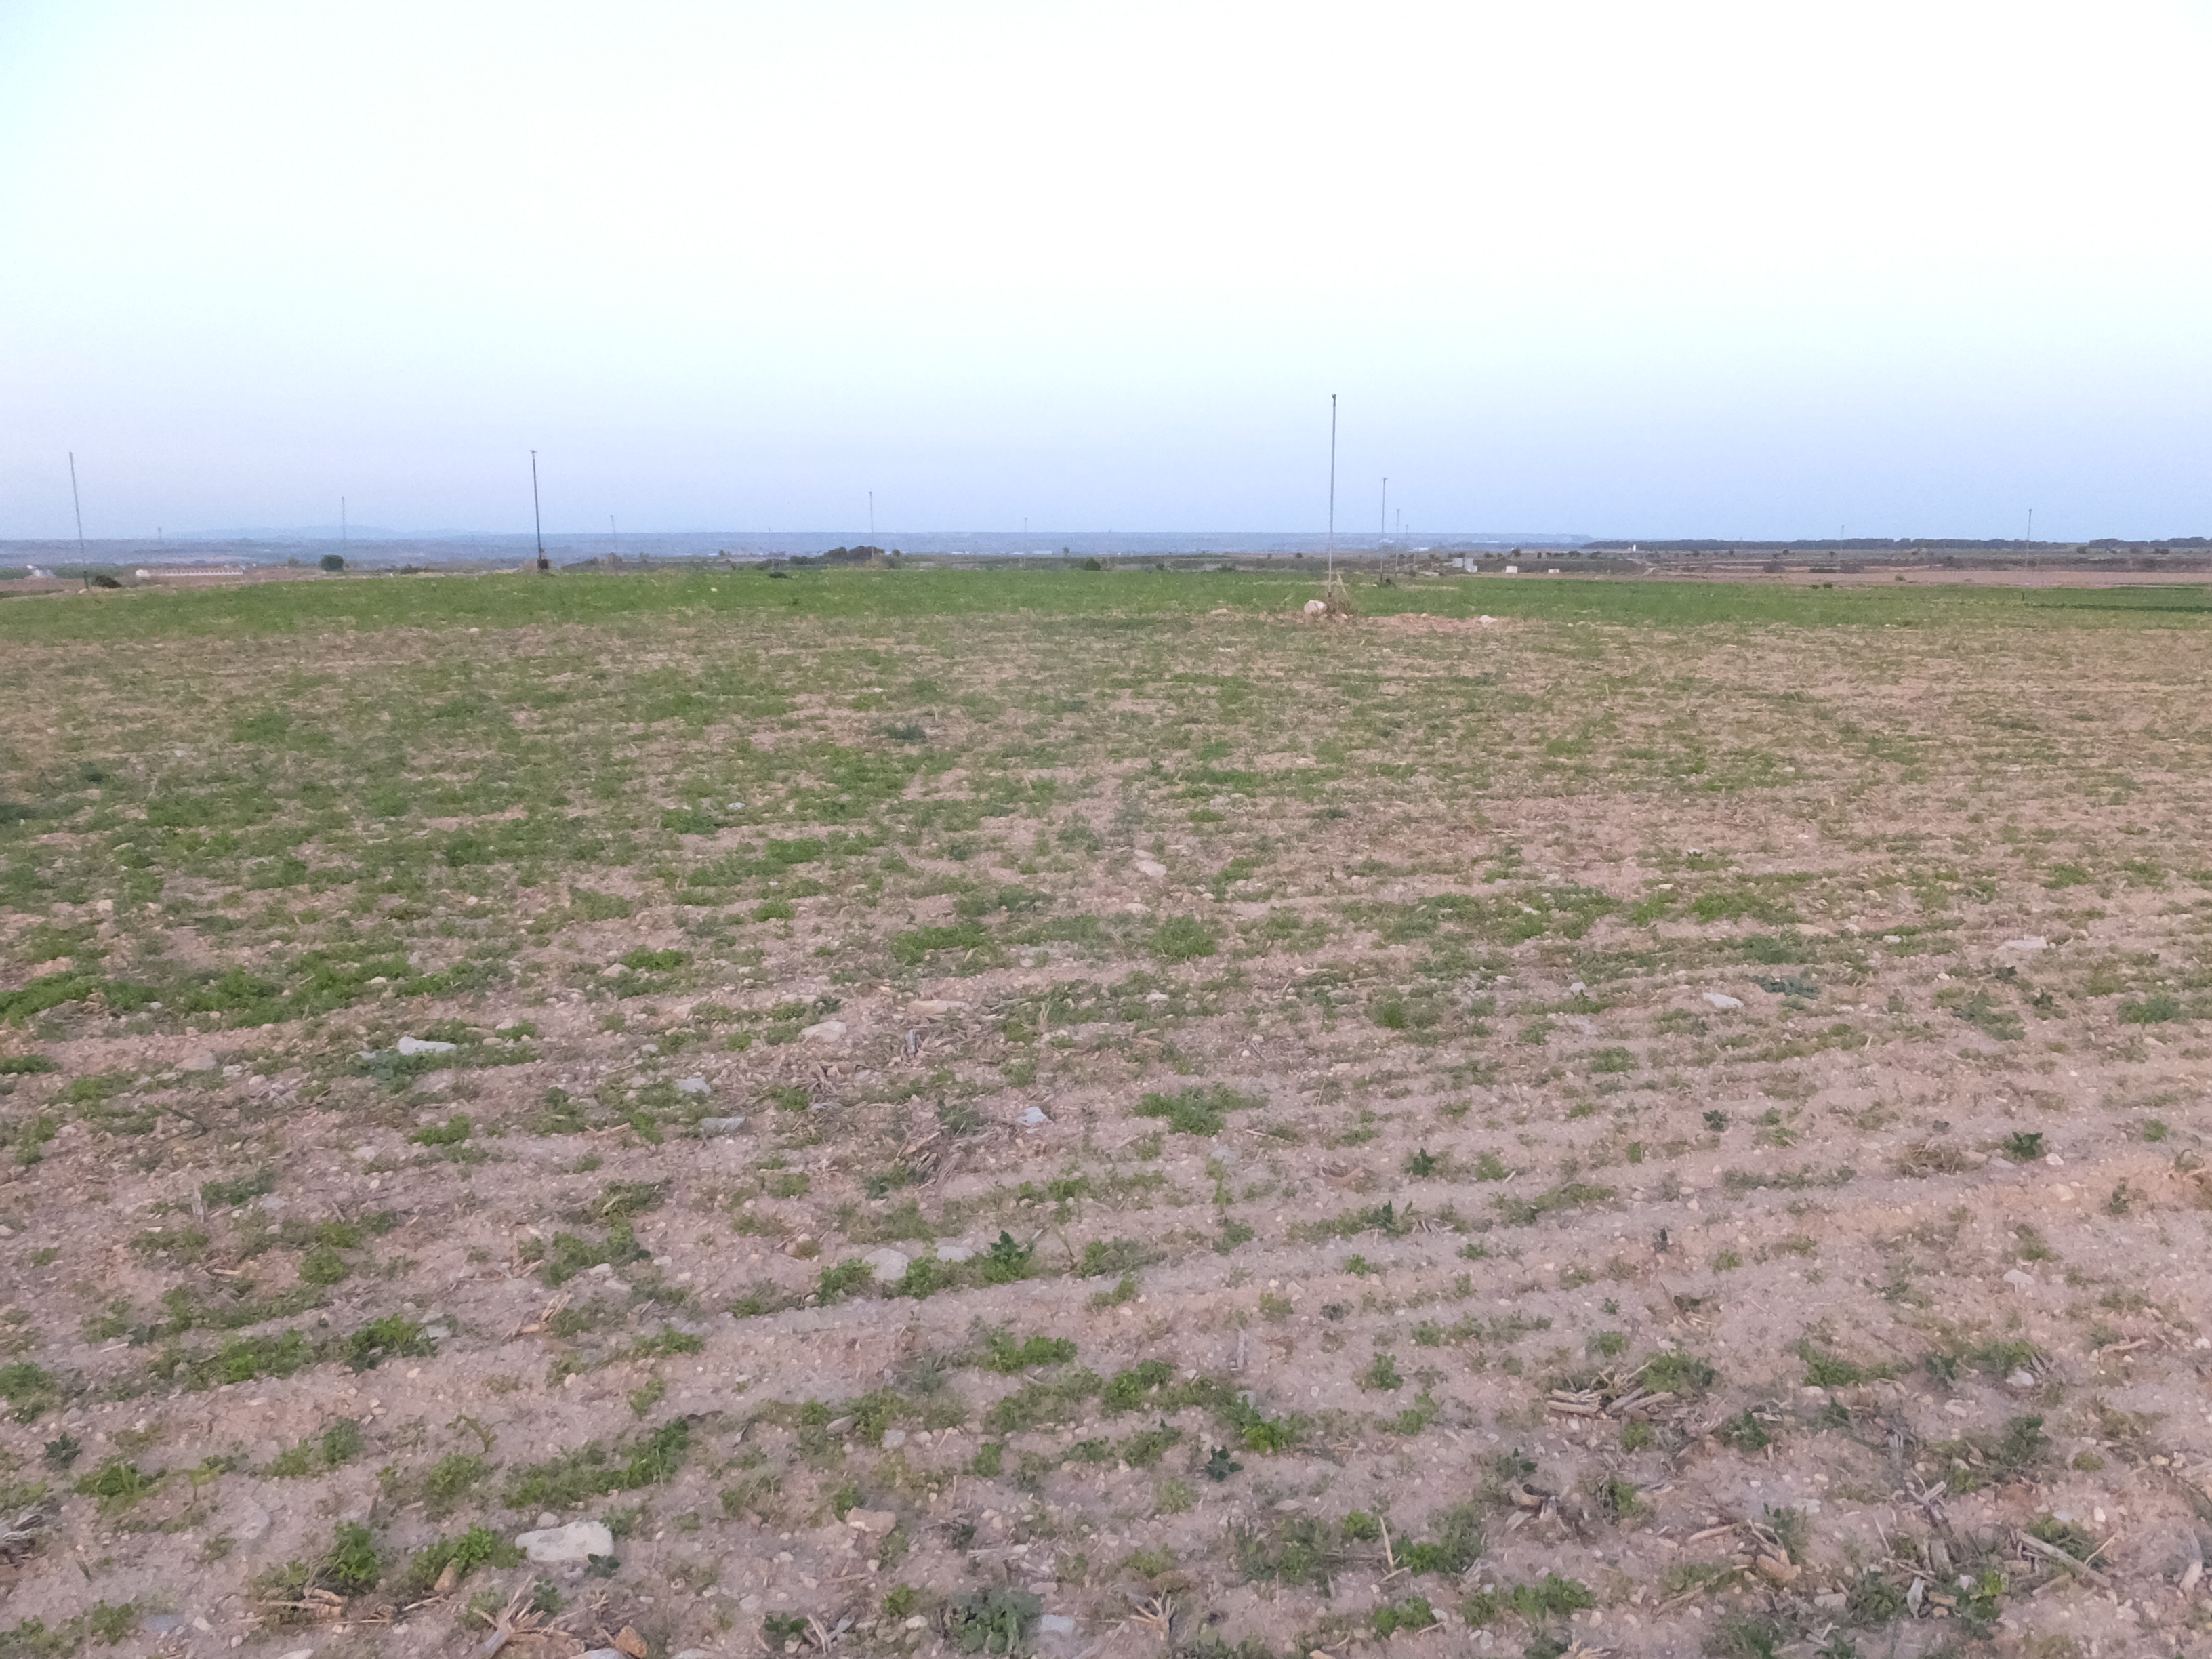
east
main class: Cropland
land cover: Lucerne
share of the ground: > 75 %
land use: Agriculture (excluding fallow land and kitchen gardens)
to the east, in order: Lucerne; Maize
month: April
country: ES
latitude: 41.8324
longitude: -0.3388
